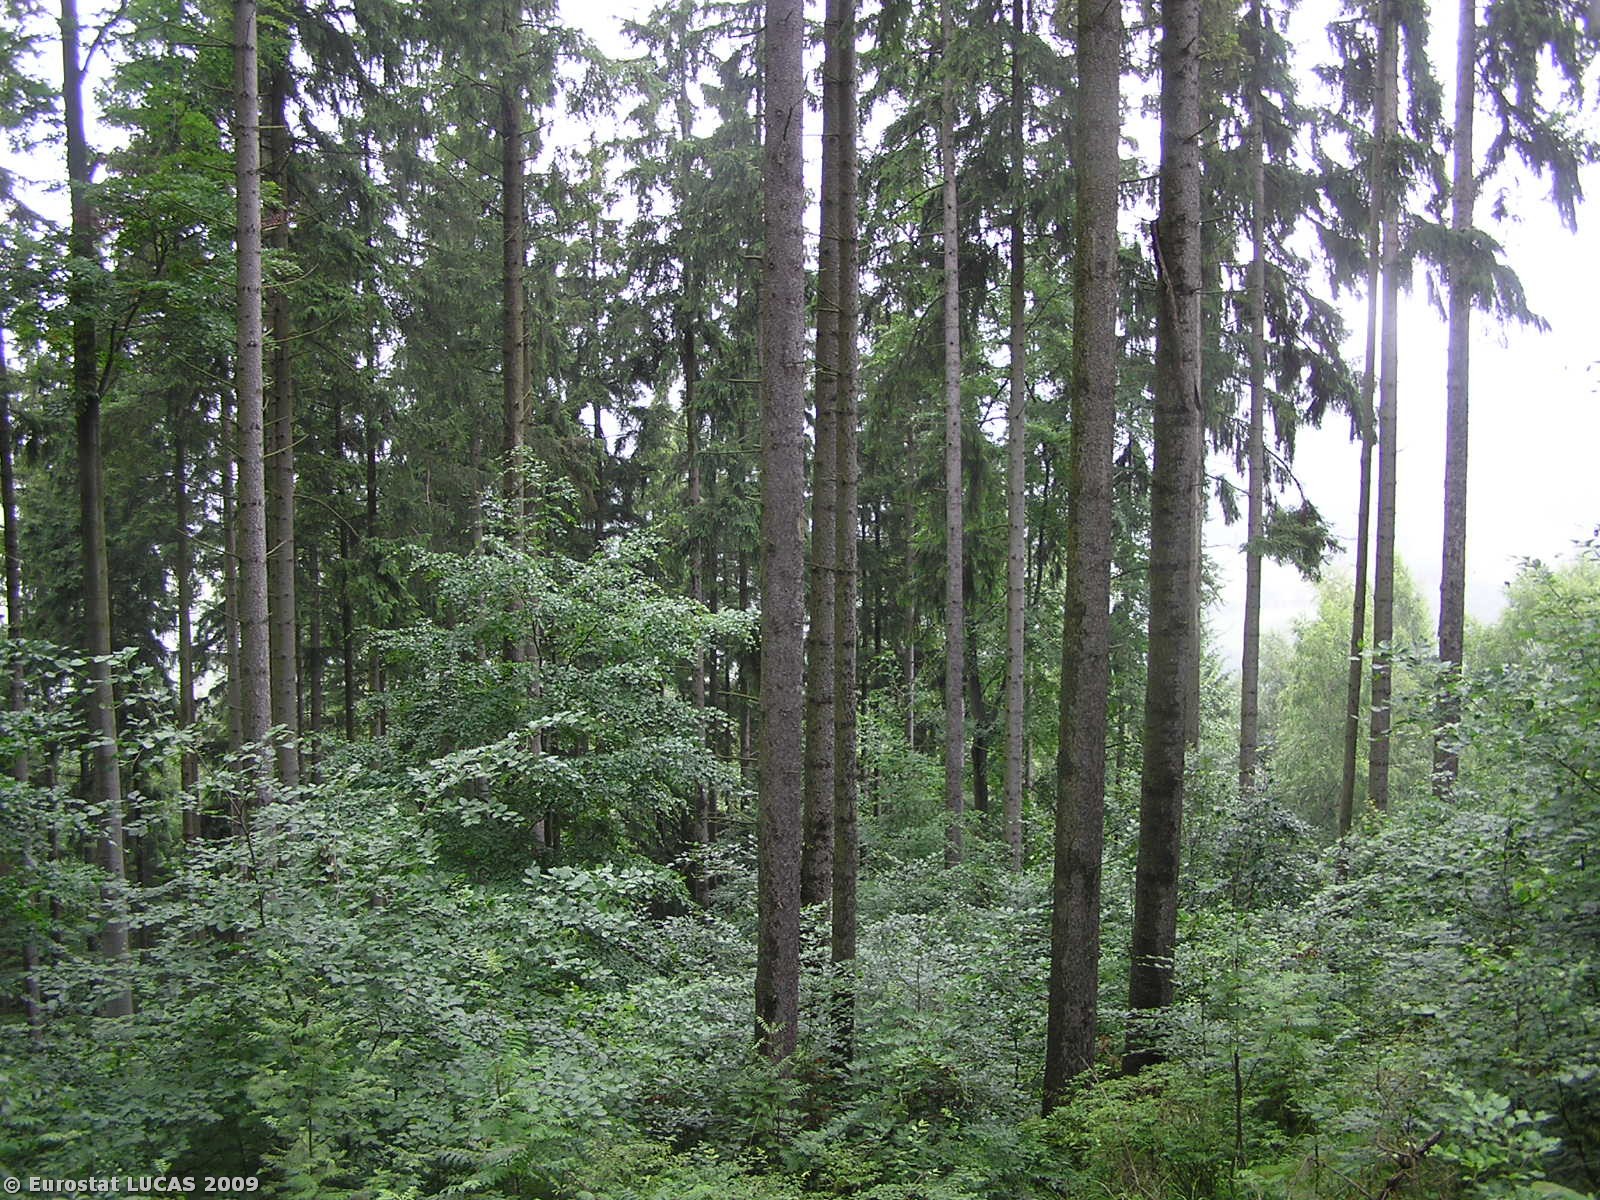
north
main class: Woodland
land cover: Mixed woodland
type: hemiboreal forest and nemoral coniferous forest and mixed broadleaved-coniferous forest
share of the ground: > 75 %
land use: Forestry
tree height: > 5 m
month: June
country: CZ
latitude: 50.1038
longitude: 17.4362
